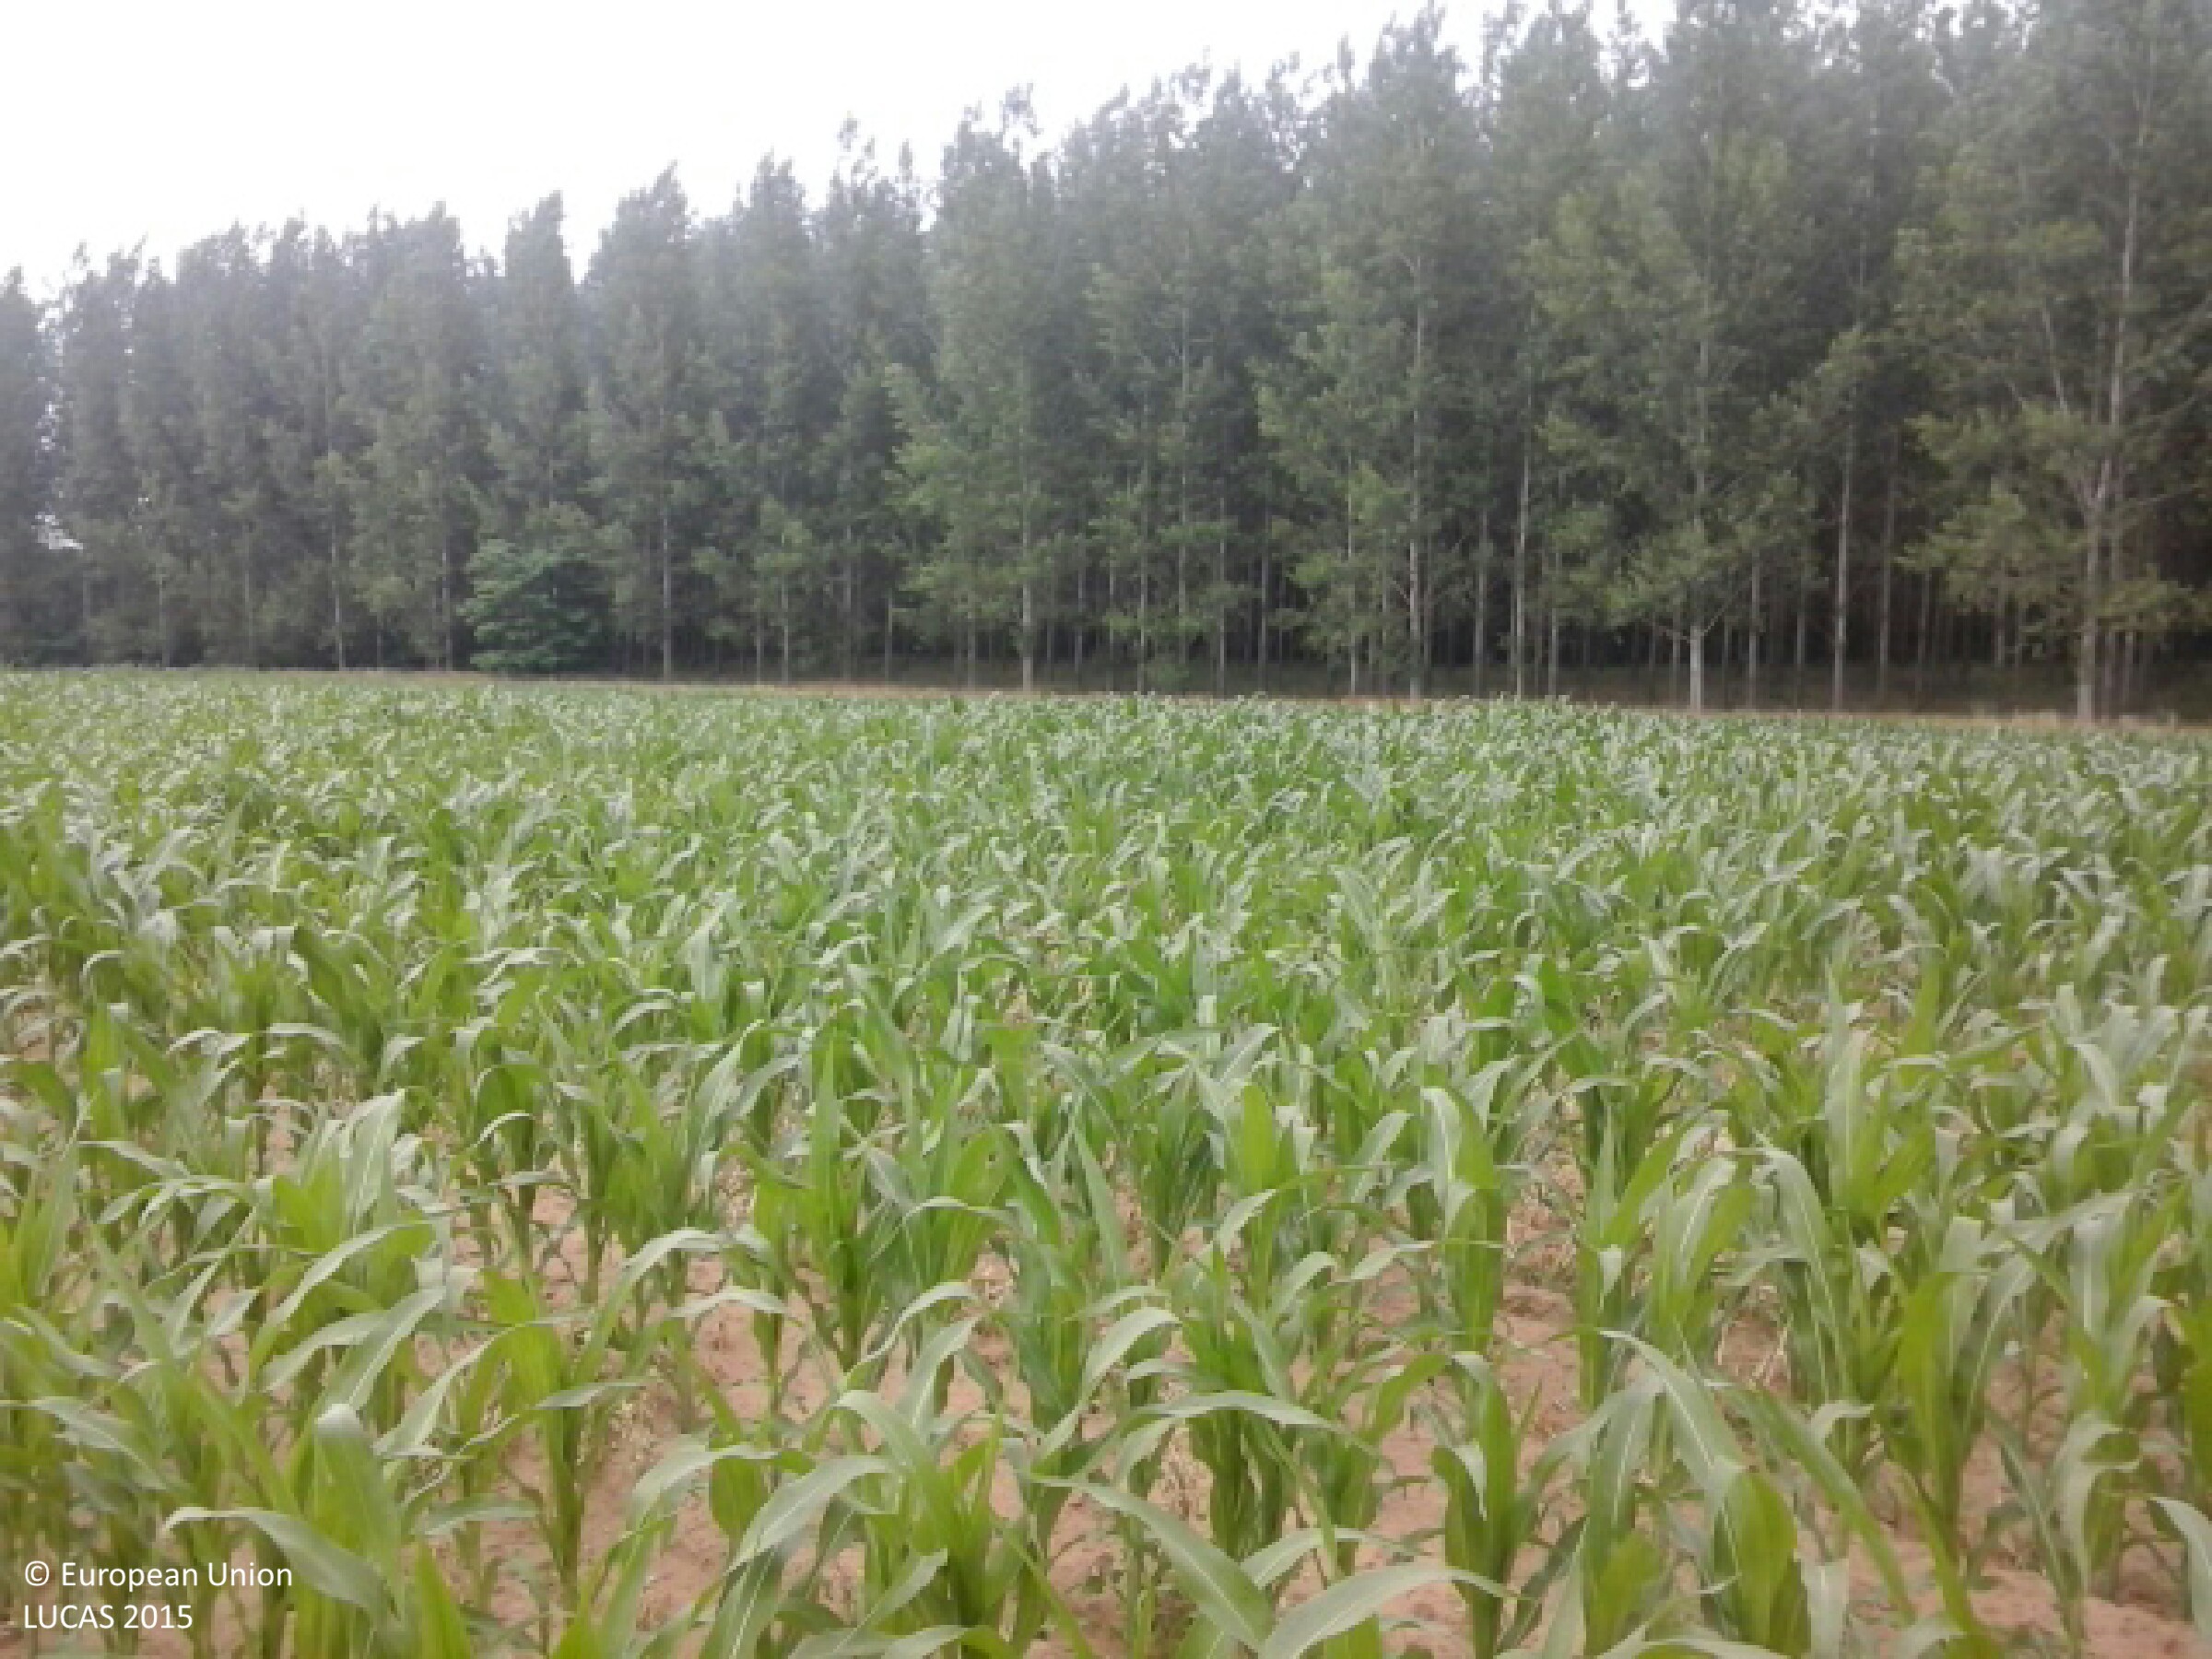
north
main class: Cropland
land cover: Maize
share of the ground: 25 - 50 %
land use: Agriculture (excluding fallow land and kitchen gardens)
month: June
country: HU
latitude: 47.9879
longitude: 22.1267
